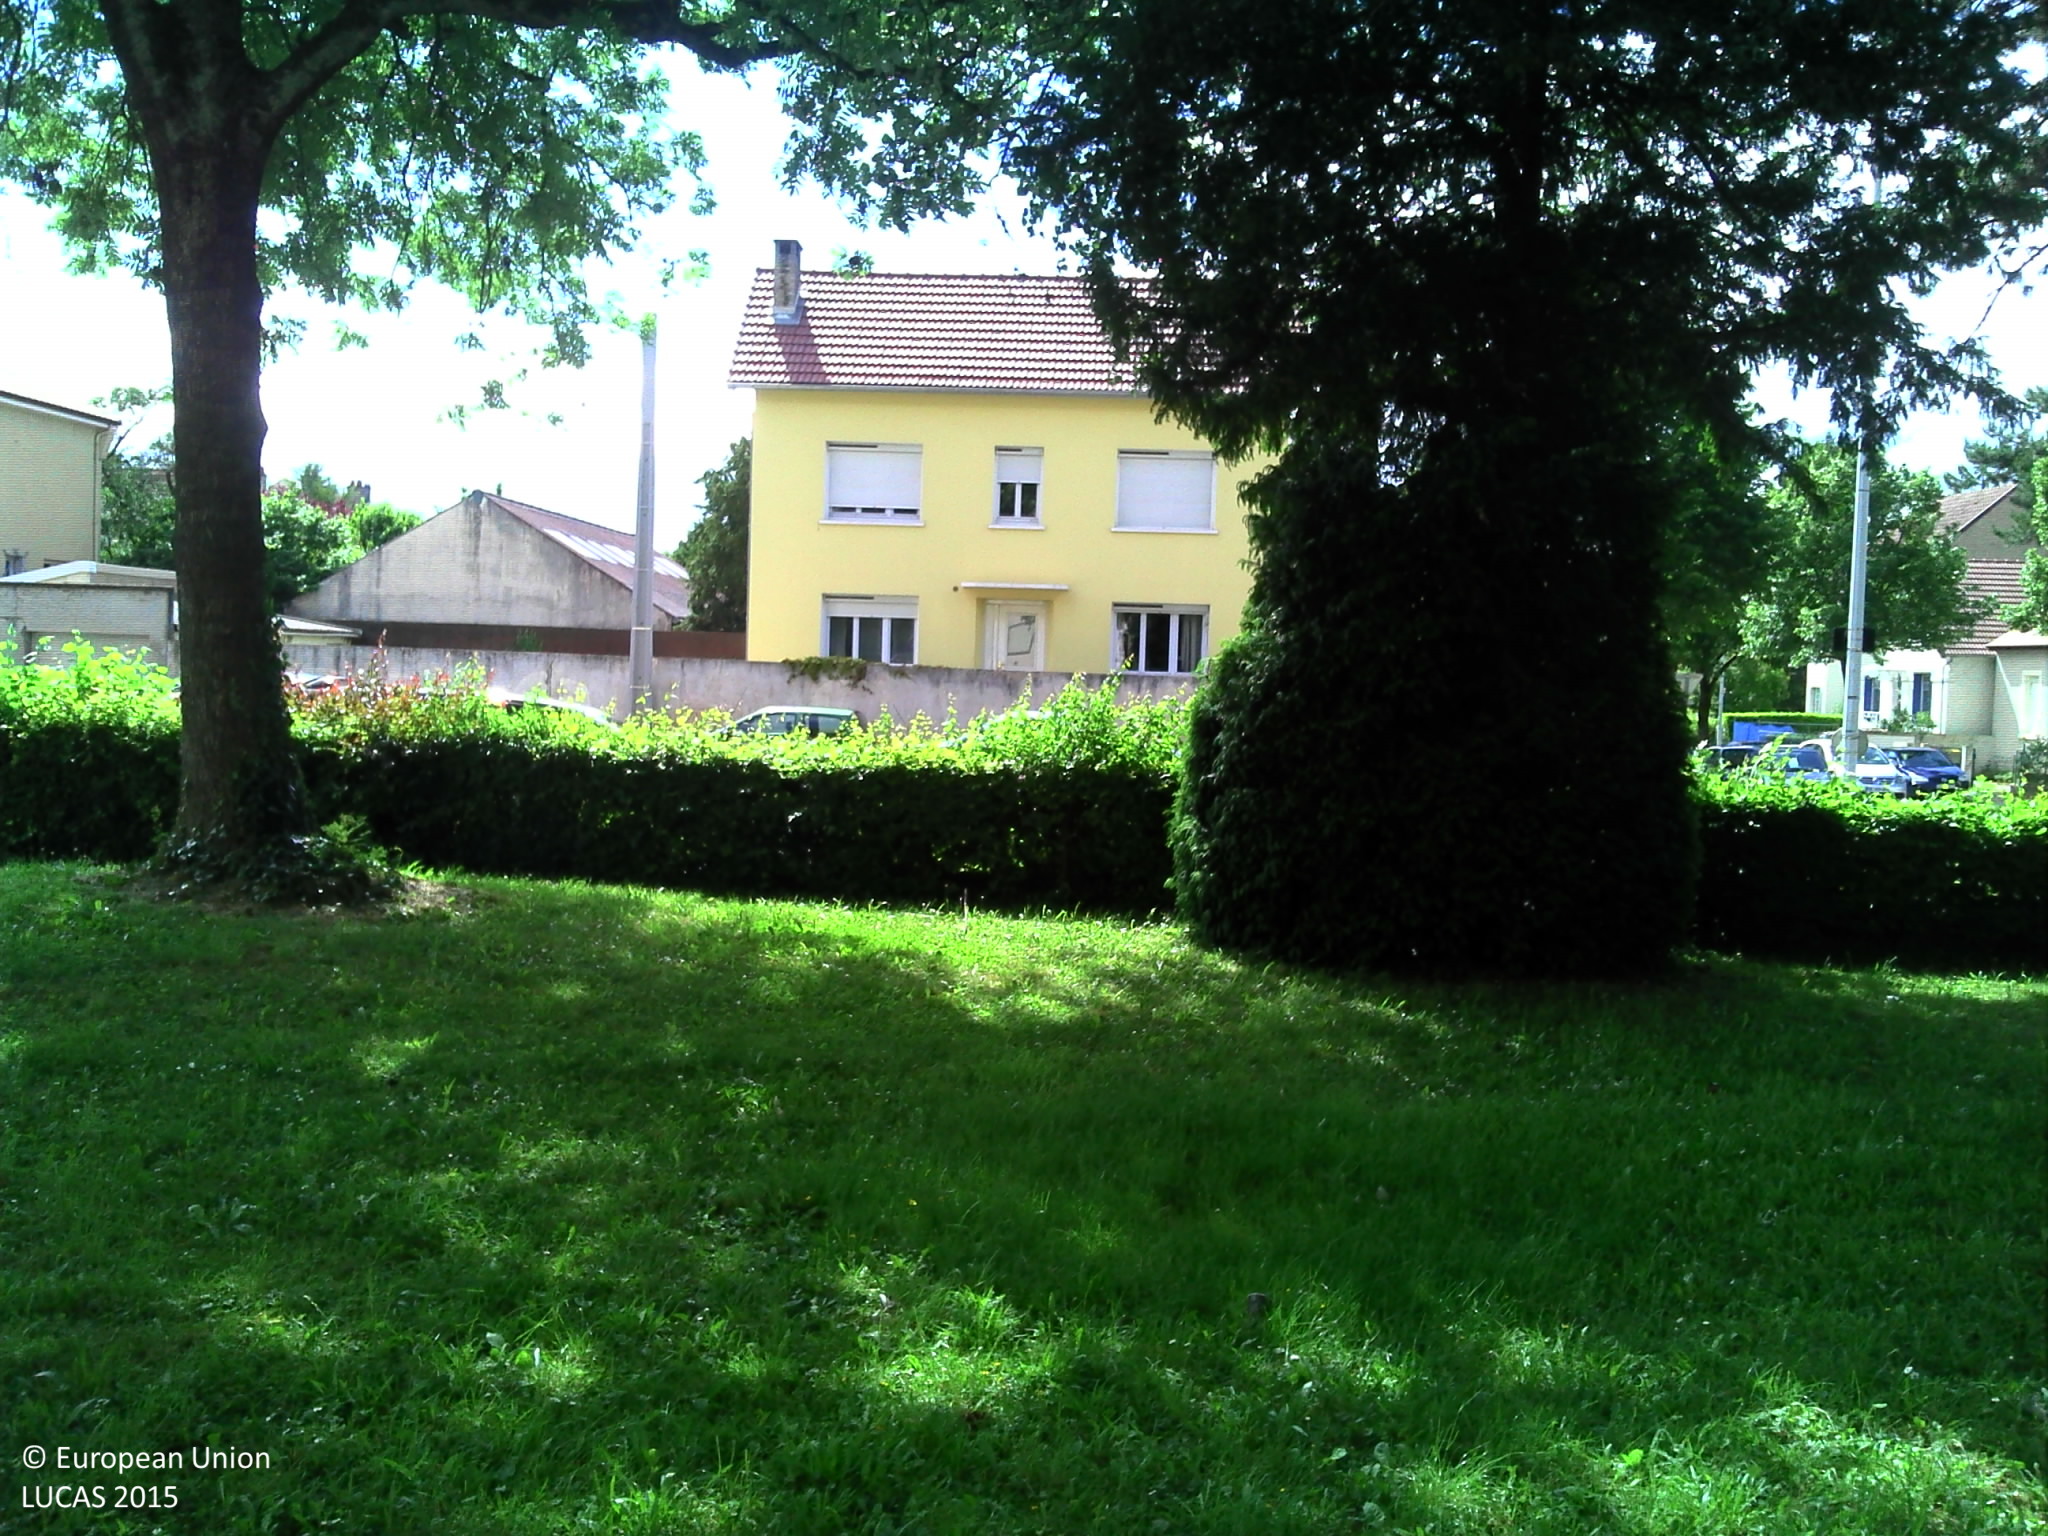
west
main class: Woodland
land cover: Pine dominated mixed woodland
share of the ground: > 75 %
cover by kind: herbaceous plants 65 %, coniferous forest trees 20 %, broadleaved forest trees 15 %
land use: Community services
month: June
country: FR
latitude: 47.3197
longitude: 5.0657
